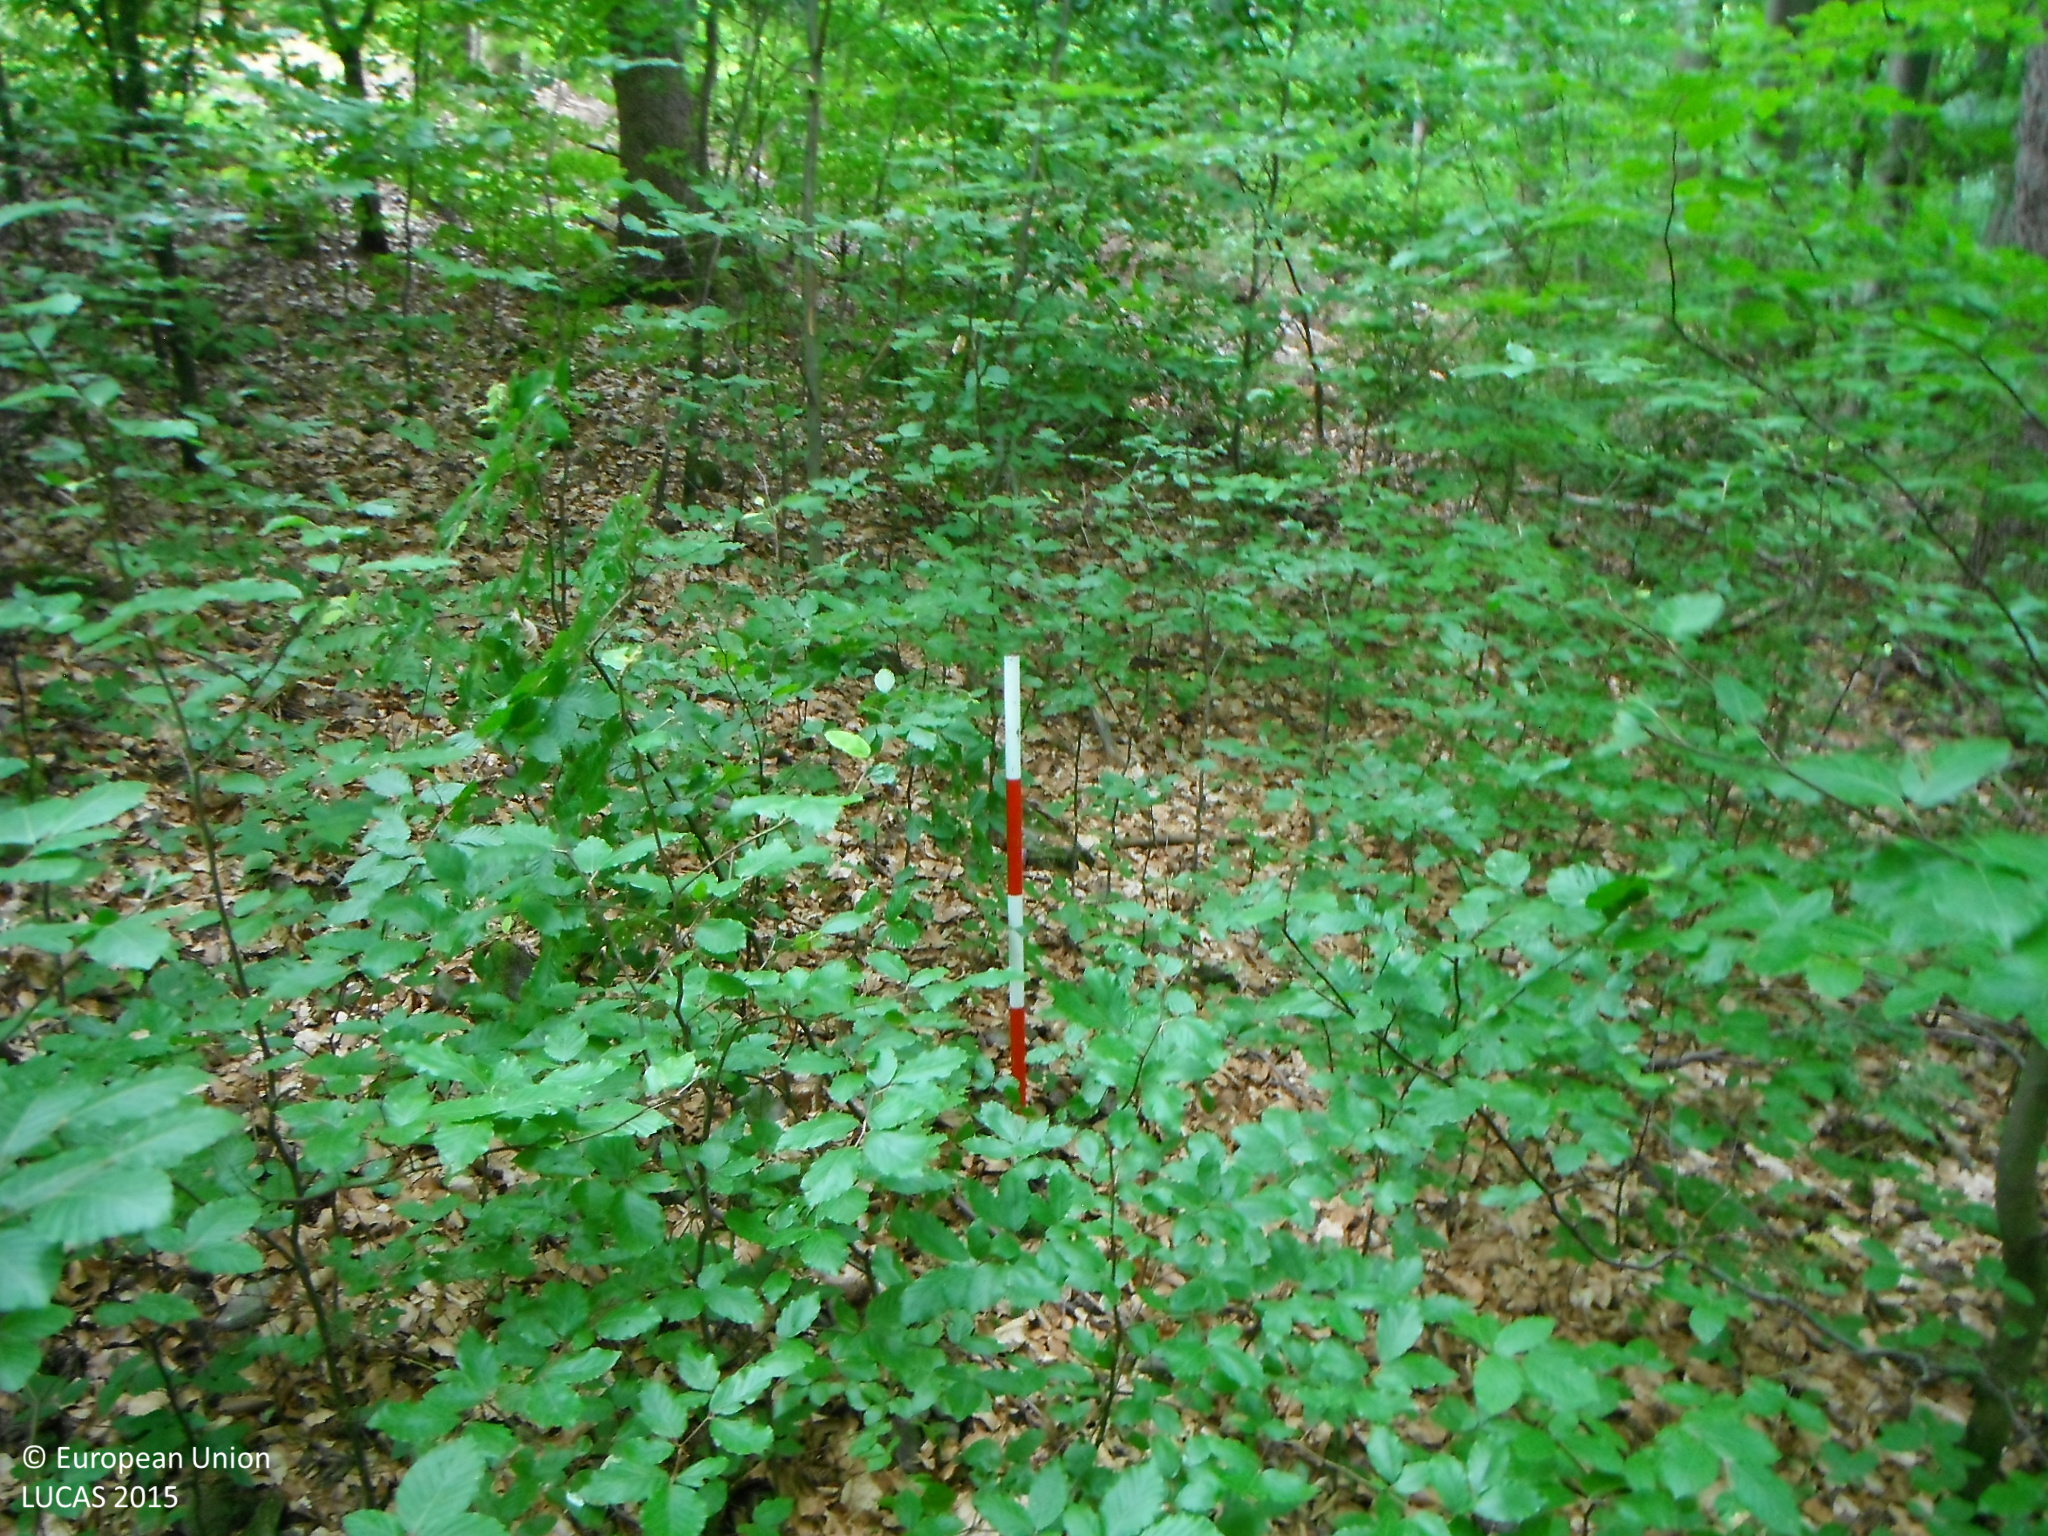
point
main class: Woodland
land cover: Spruce dominated mixed woodland
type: alpine coniferous forest
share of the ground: > 75 %
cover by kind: coniferous forest trees 60 %, broadleaved forest trees 40 %
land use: Forestry
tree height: > 5 m
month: June
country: SK
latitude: 48.5204
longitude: 19.2701
